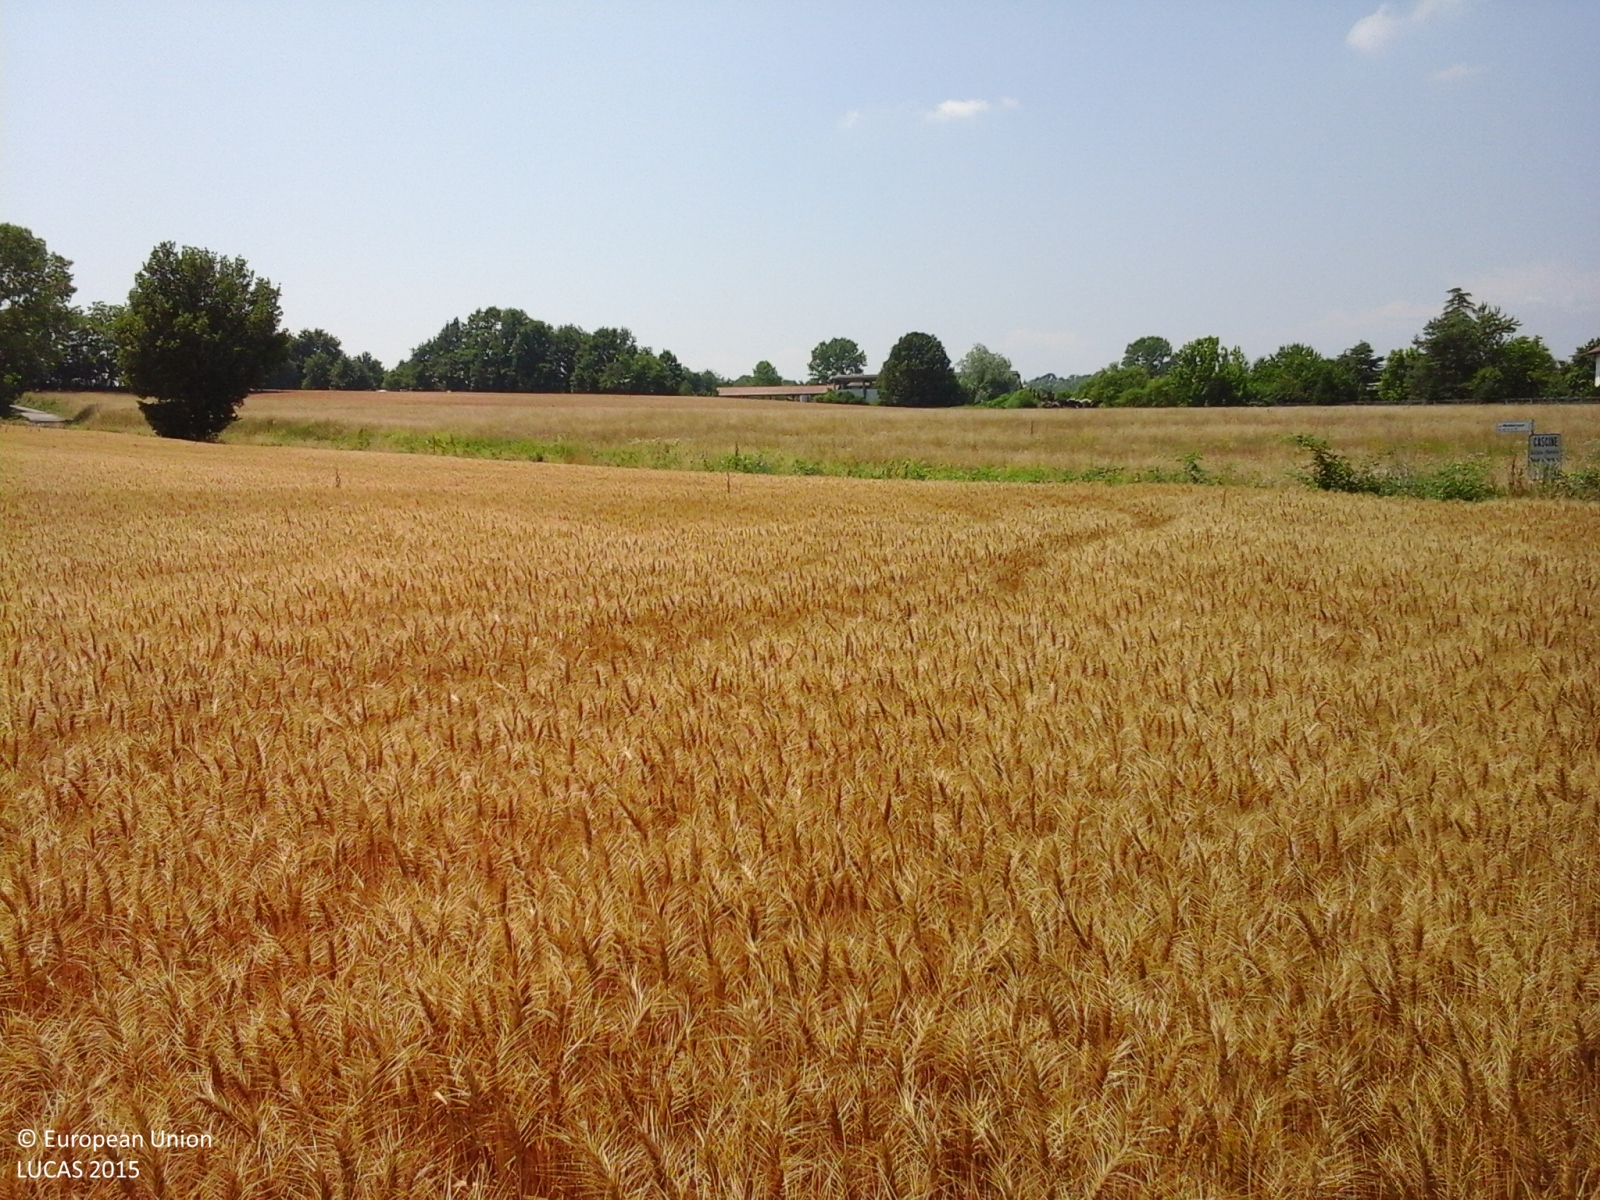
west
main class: Cropland
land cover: Common wheat
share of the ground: > 75 %
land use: Agriculture (excluding fallow land and kitchen gardens)
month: June
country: IT
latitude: 44.8270
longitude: 8.5231
